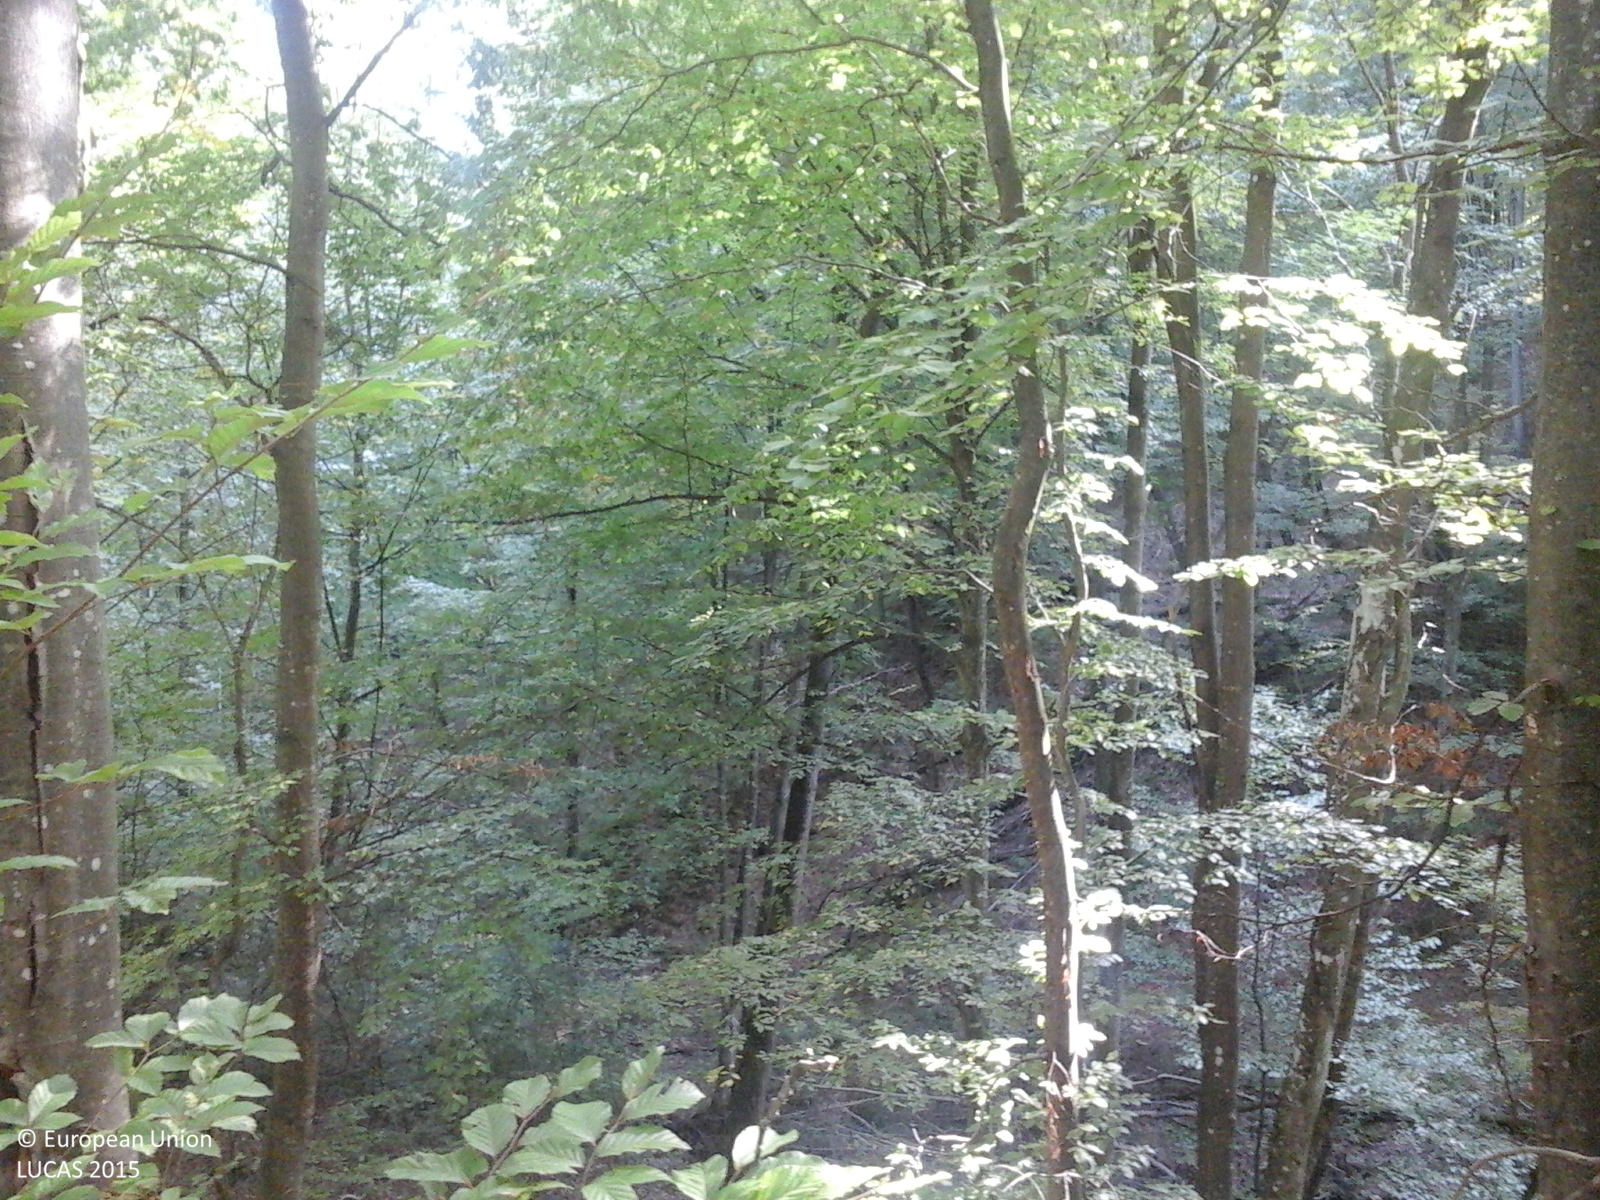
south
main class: Woodland
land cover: Broadleaved woodland
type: mesophytic deciduous forest
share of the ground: > 75 %
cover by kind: broadleaved forest trees 100 %
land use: Forestry
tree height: > 5 m
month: September
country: RO
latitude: 47.2548
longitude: 23.8343
